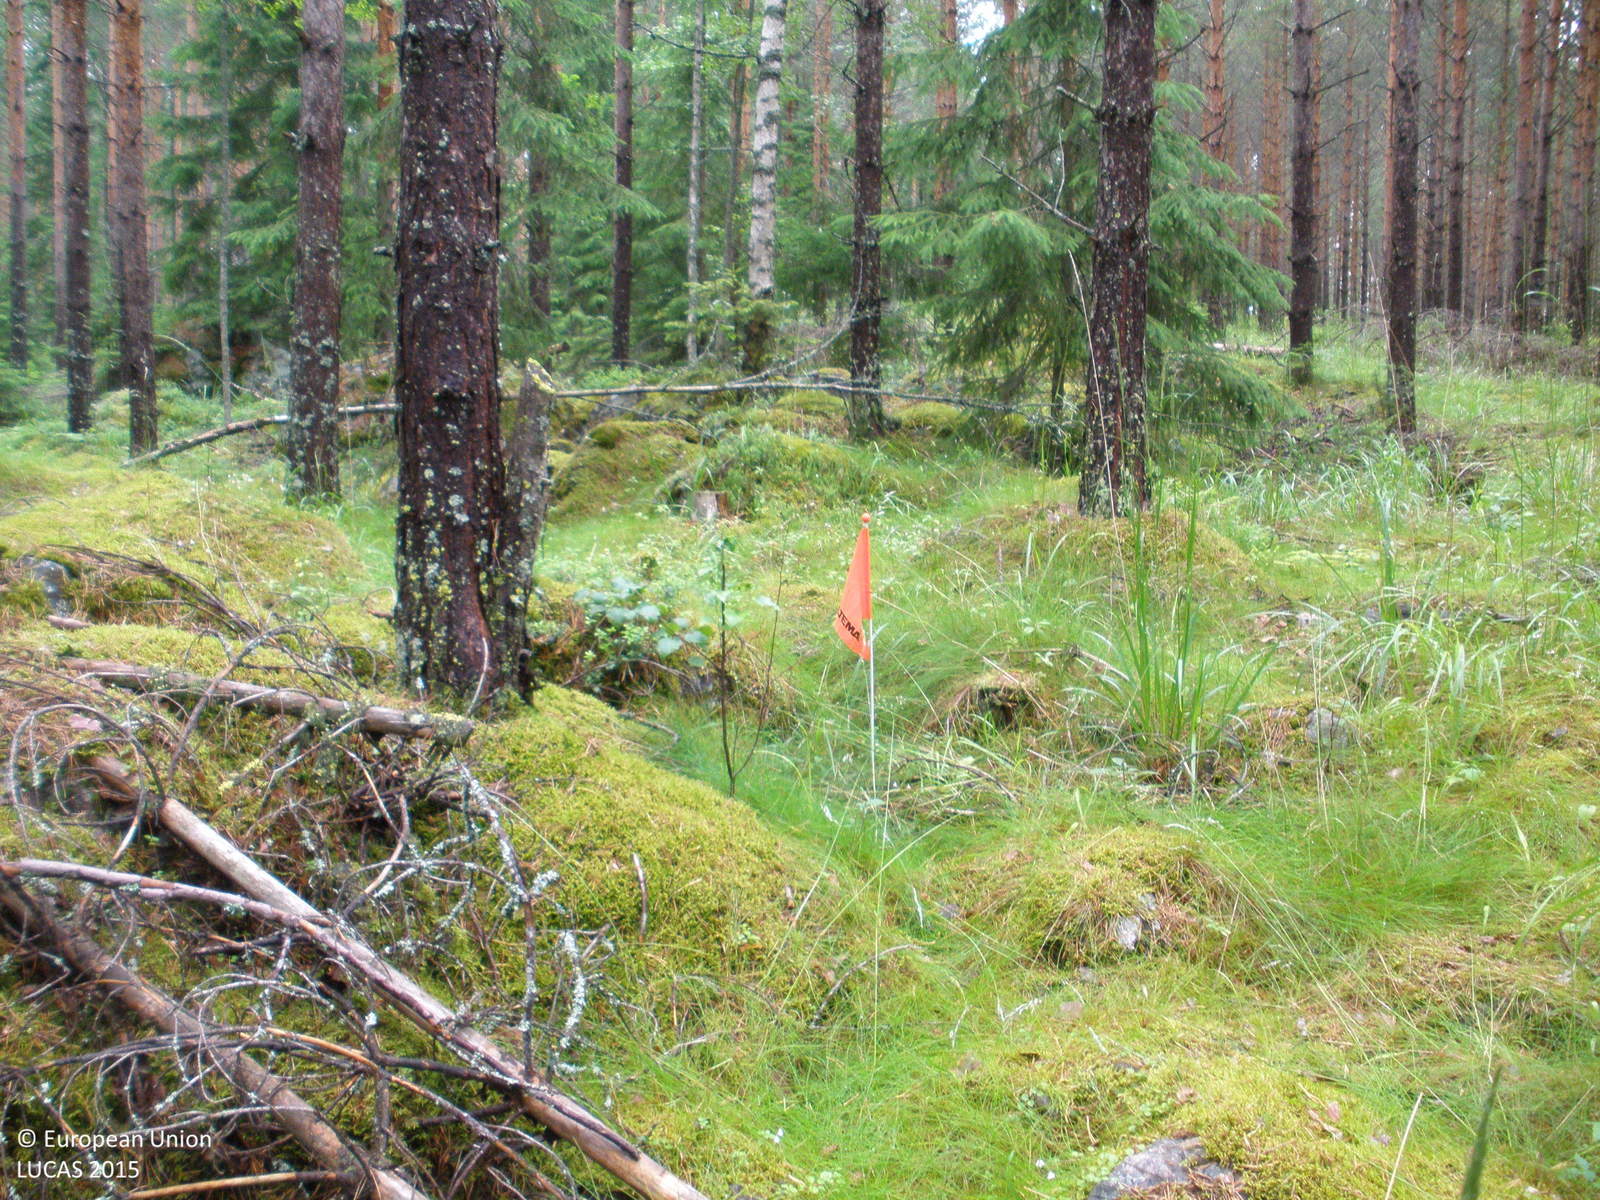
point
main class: Woodland
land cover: Pine dominated coniferous woodland
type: boreal forest
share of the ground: > 75 %
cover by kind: coniferous forest trees 80 %, lichens and mosses 10 %, broadleaved forest trees 5 %, herbaceous plants 5 %
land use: Forestry
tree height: > 5 m
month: July
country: FI
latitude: 61.3870
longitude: 23.1971
